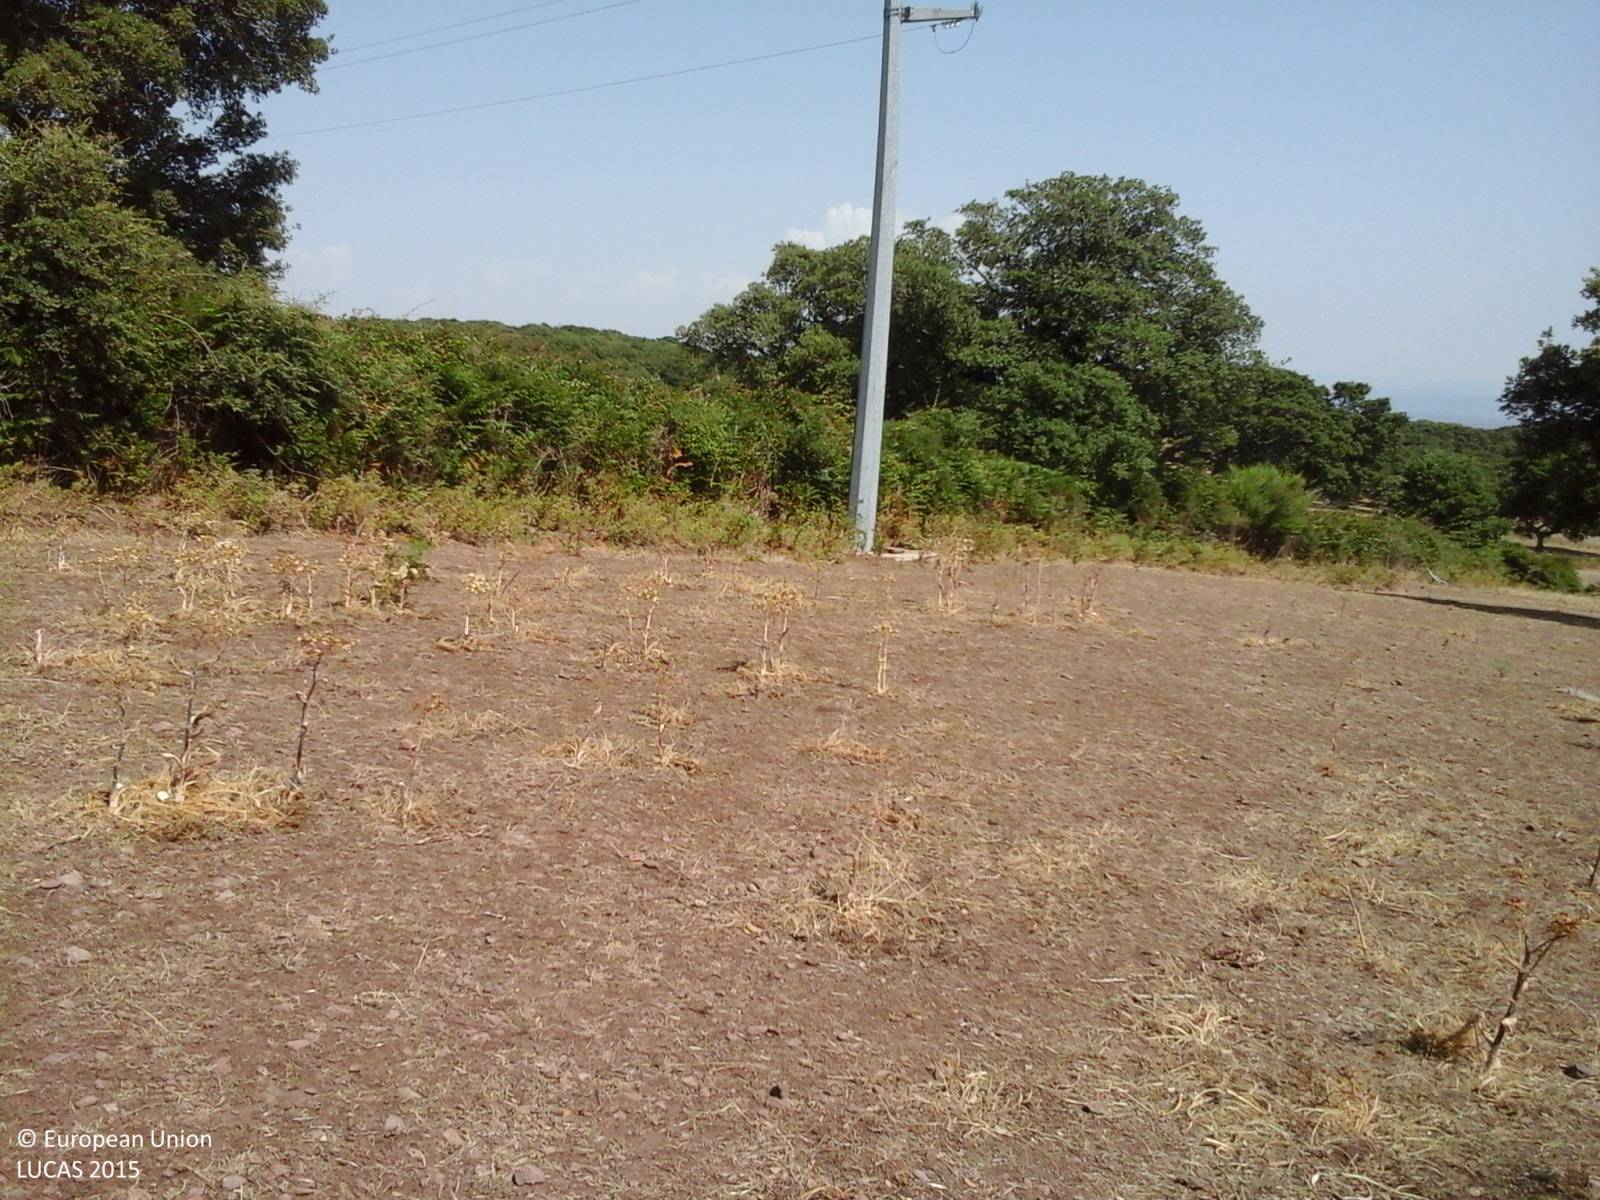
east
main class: Grassland
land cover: Grassland without tree/shrub cover
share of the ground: > 75 %
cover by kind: herbaceous plants 100 %
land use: Agriculture (excluding fallow land and kitchen gardens)
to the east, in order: Grassland without tree/shrub cover; Abandoned hedges; Grassland with sparse tree/shrub cover; Electric lines; Abandoned hedges; Grassland with sparse tree/shrub cover
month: July
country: IT
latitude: 40.1130
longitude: 8.6346
